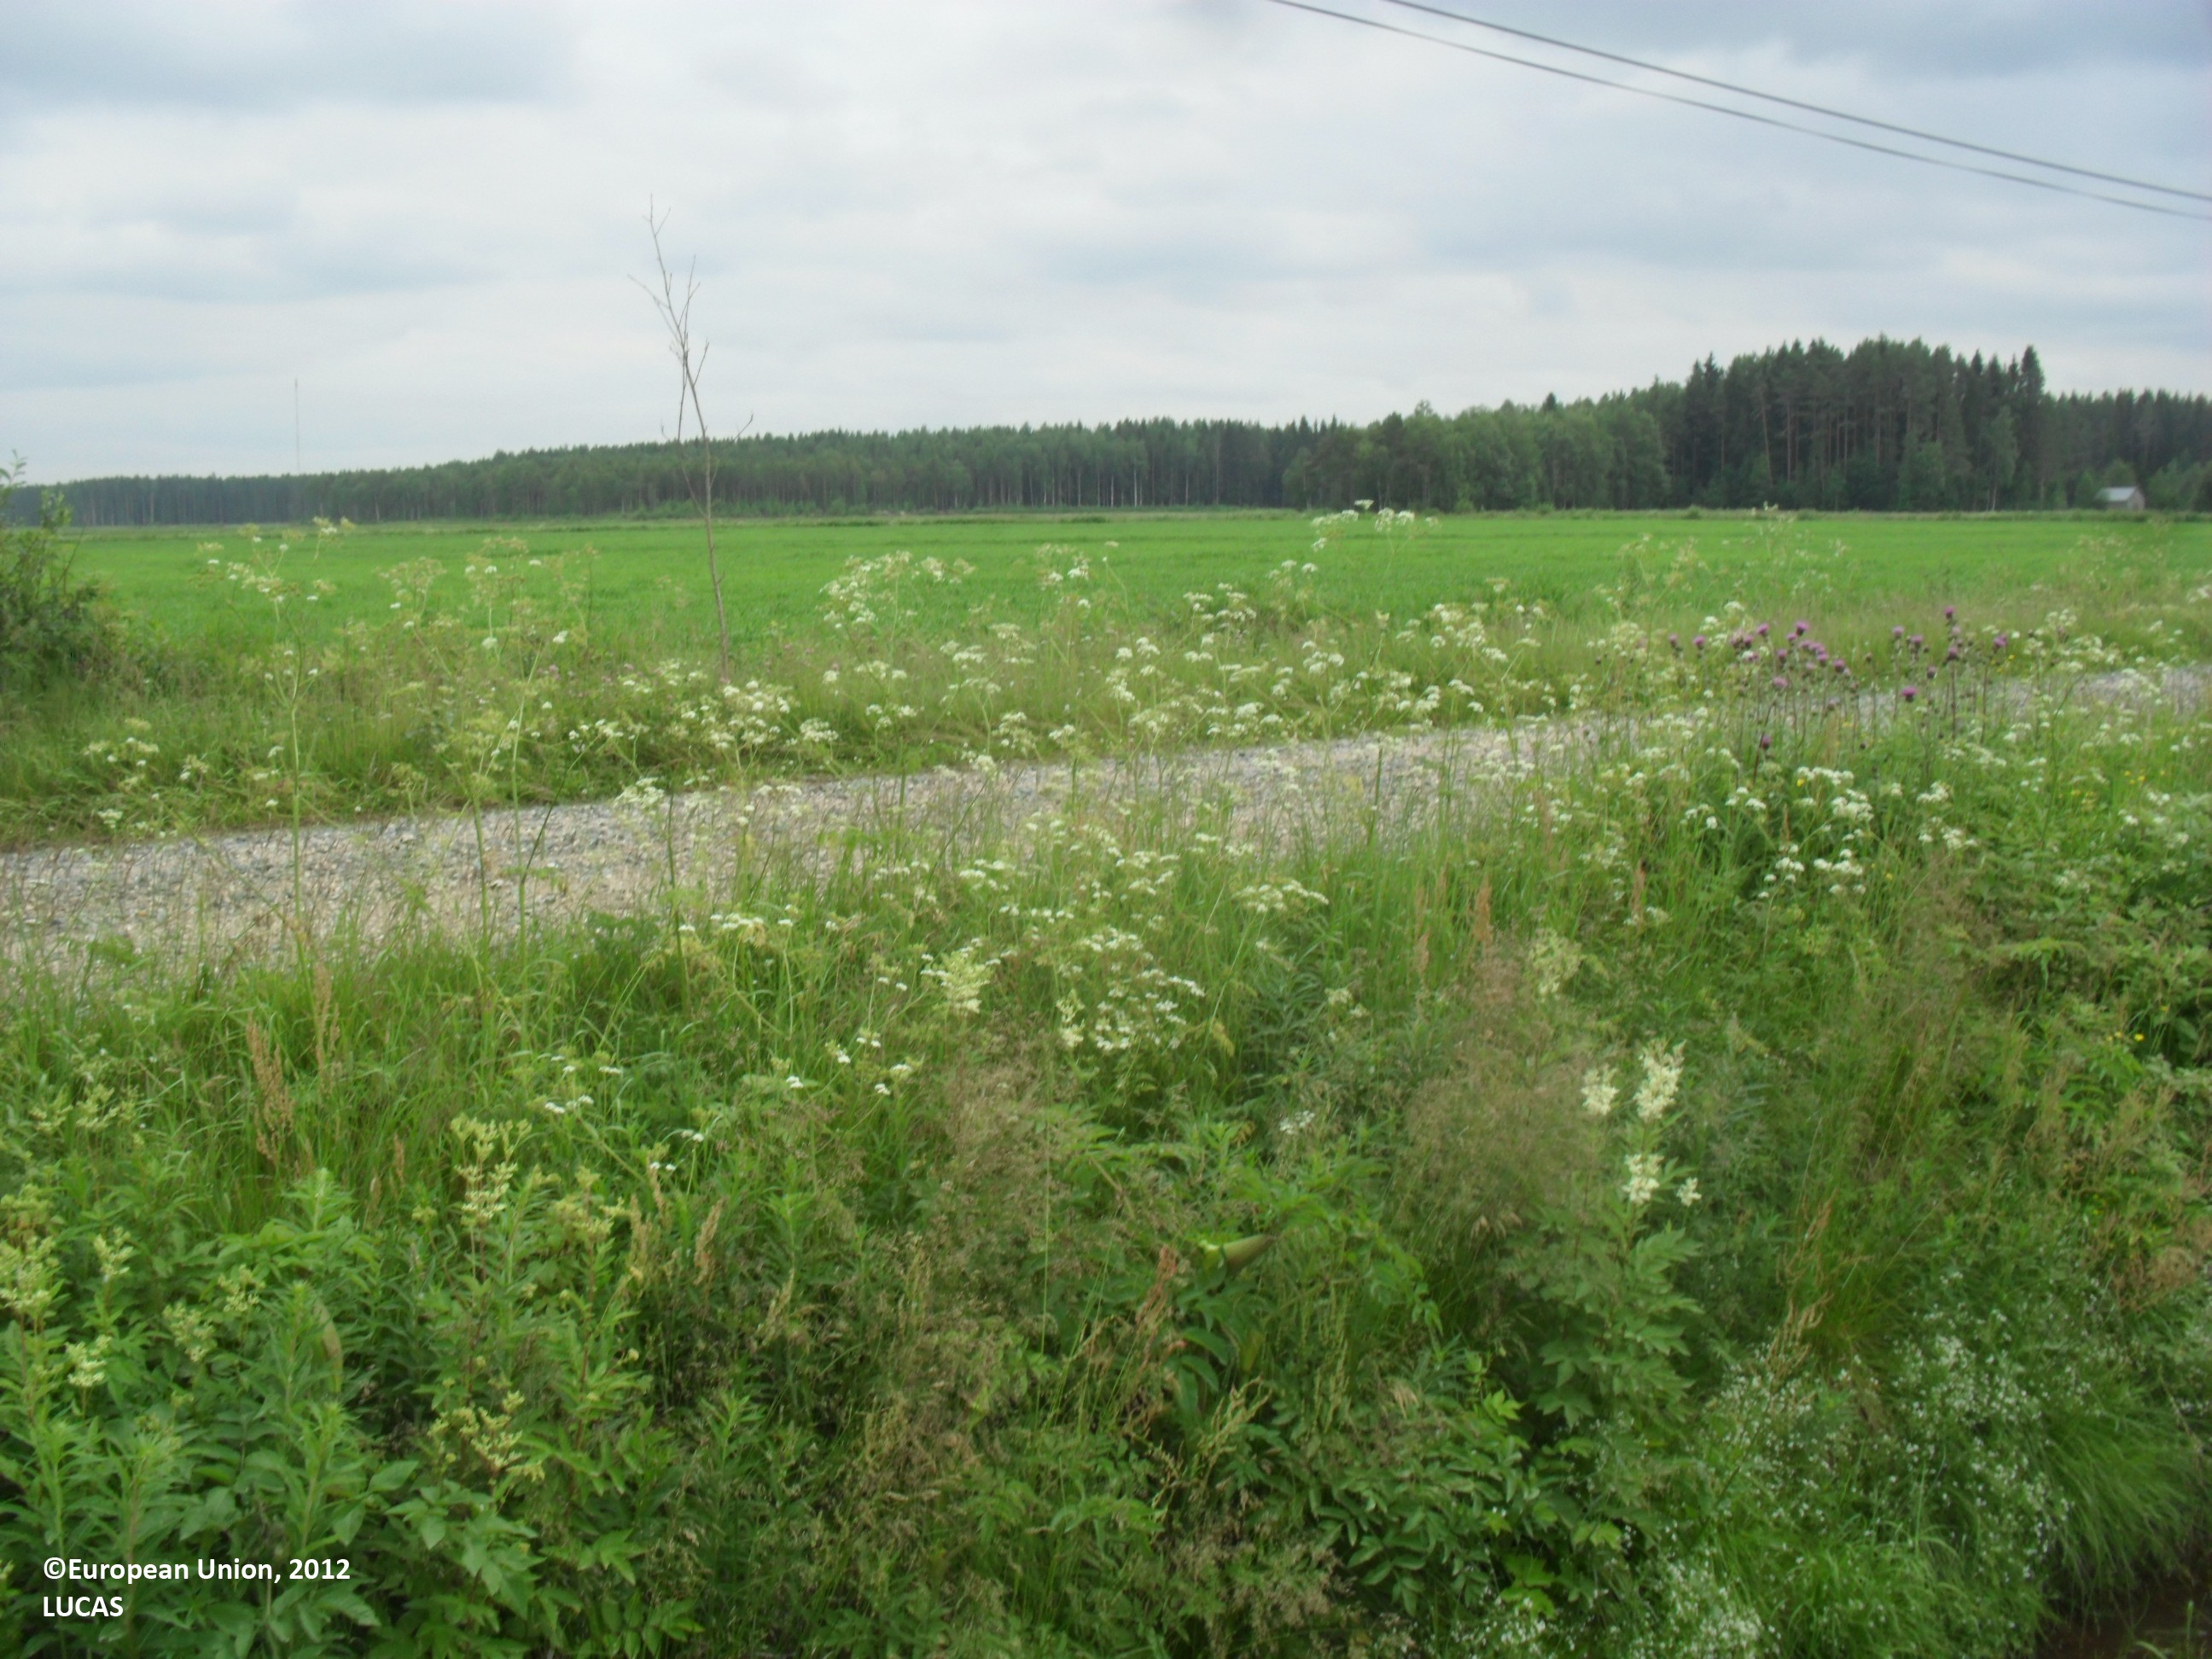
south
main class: Cropland
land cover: Barley
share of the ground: > 75 %
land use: Agriculture (excluding fallow land and kitchen gardens)
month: July
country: FI
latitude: 63.5971
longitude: 23.5053
